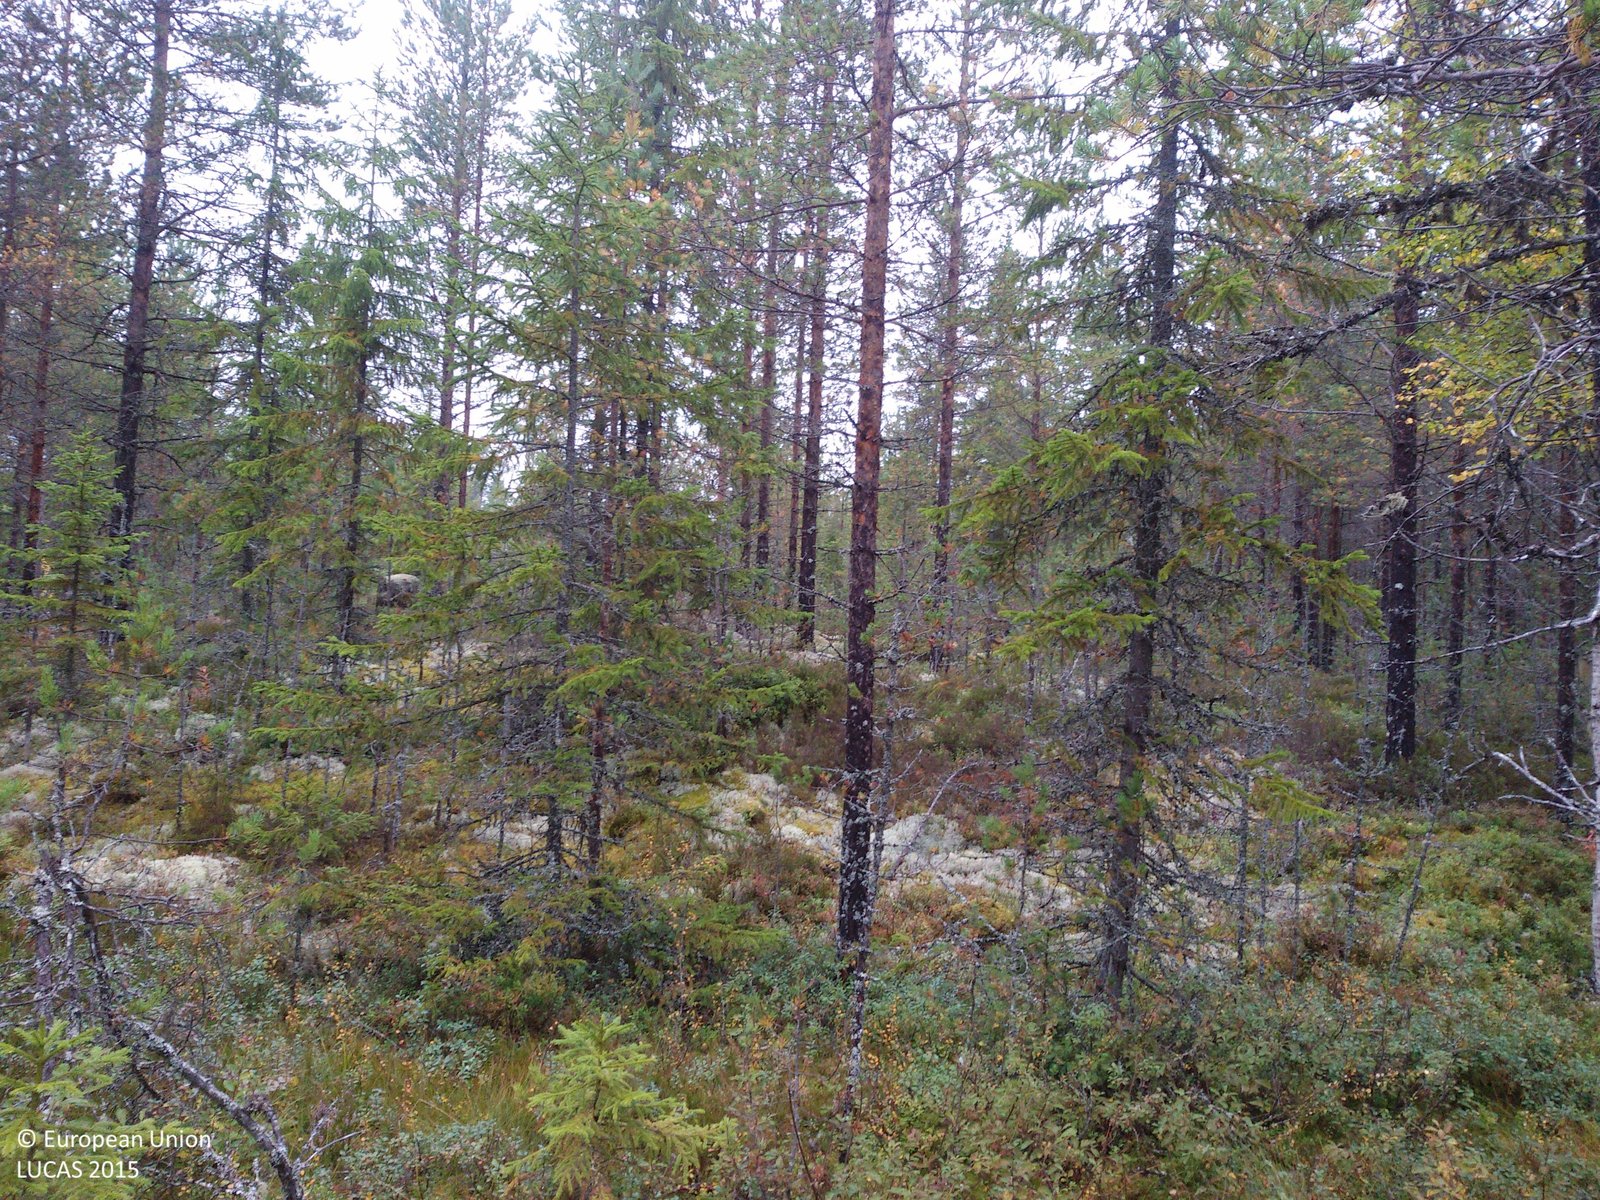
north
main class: Woodland
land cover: Pine dominated coniferous woodland
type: boreal forest
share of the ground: 50 - 75 %
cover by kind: coniferous forest trees 60 %, herbaceous plants 20 %, lichens and mosses 20 %
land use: Forestry
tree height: > 5 m
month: September
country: SE
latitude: 60.9293
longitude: 14.2123
